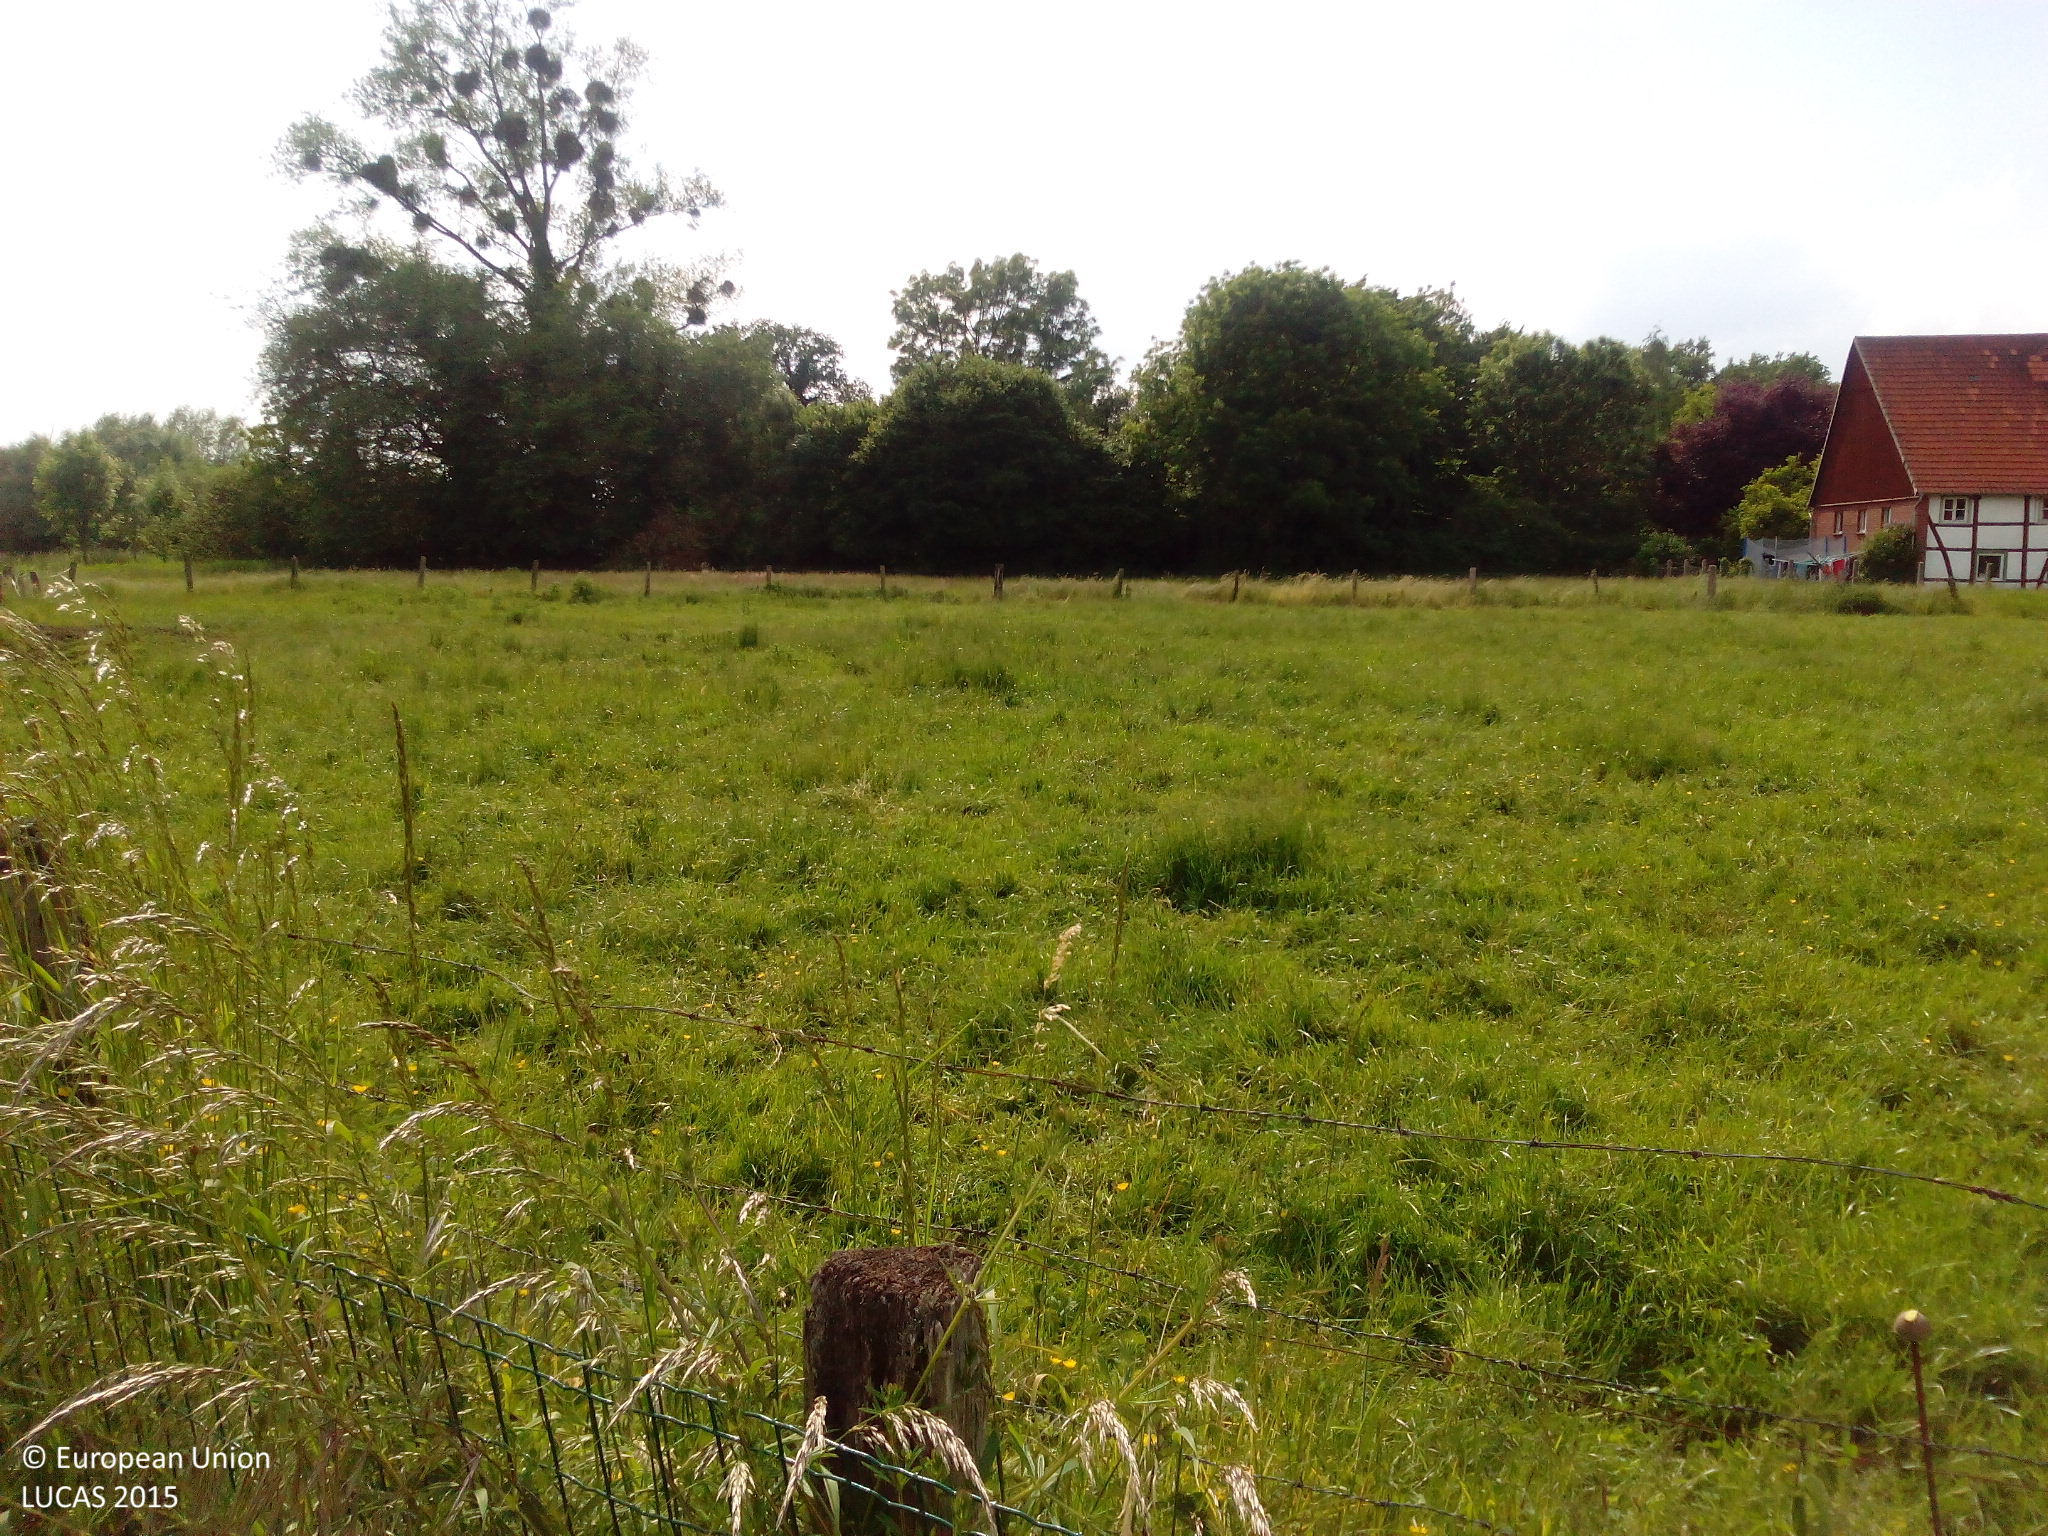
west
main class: Grassland
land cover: Grassland without tree/shrub cover
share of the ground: > 75 %
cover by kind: herbaceous plants 100 %
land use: Agriculture (excluding fallow land and kitchen gardens)
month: June
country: DE
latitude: 51.6408
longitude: 7.9629
